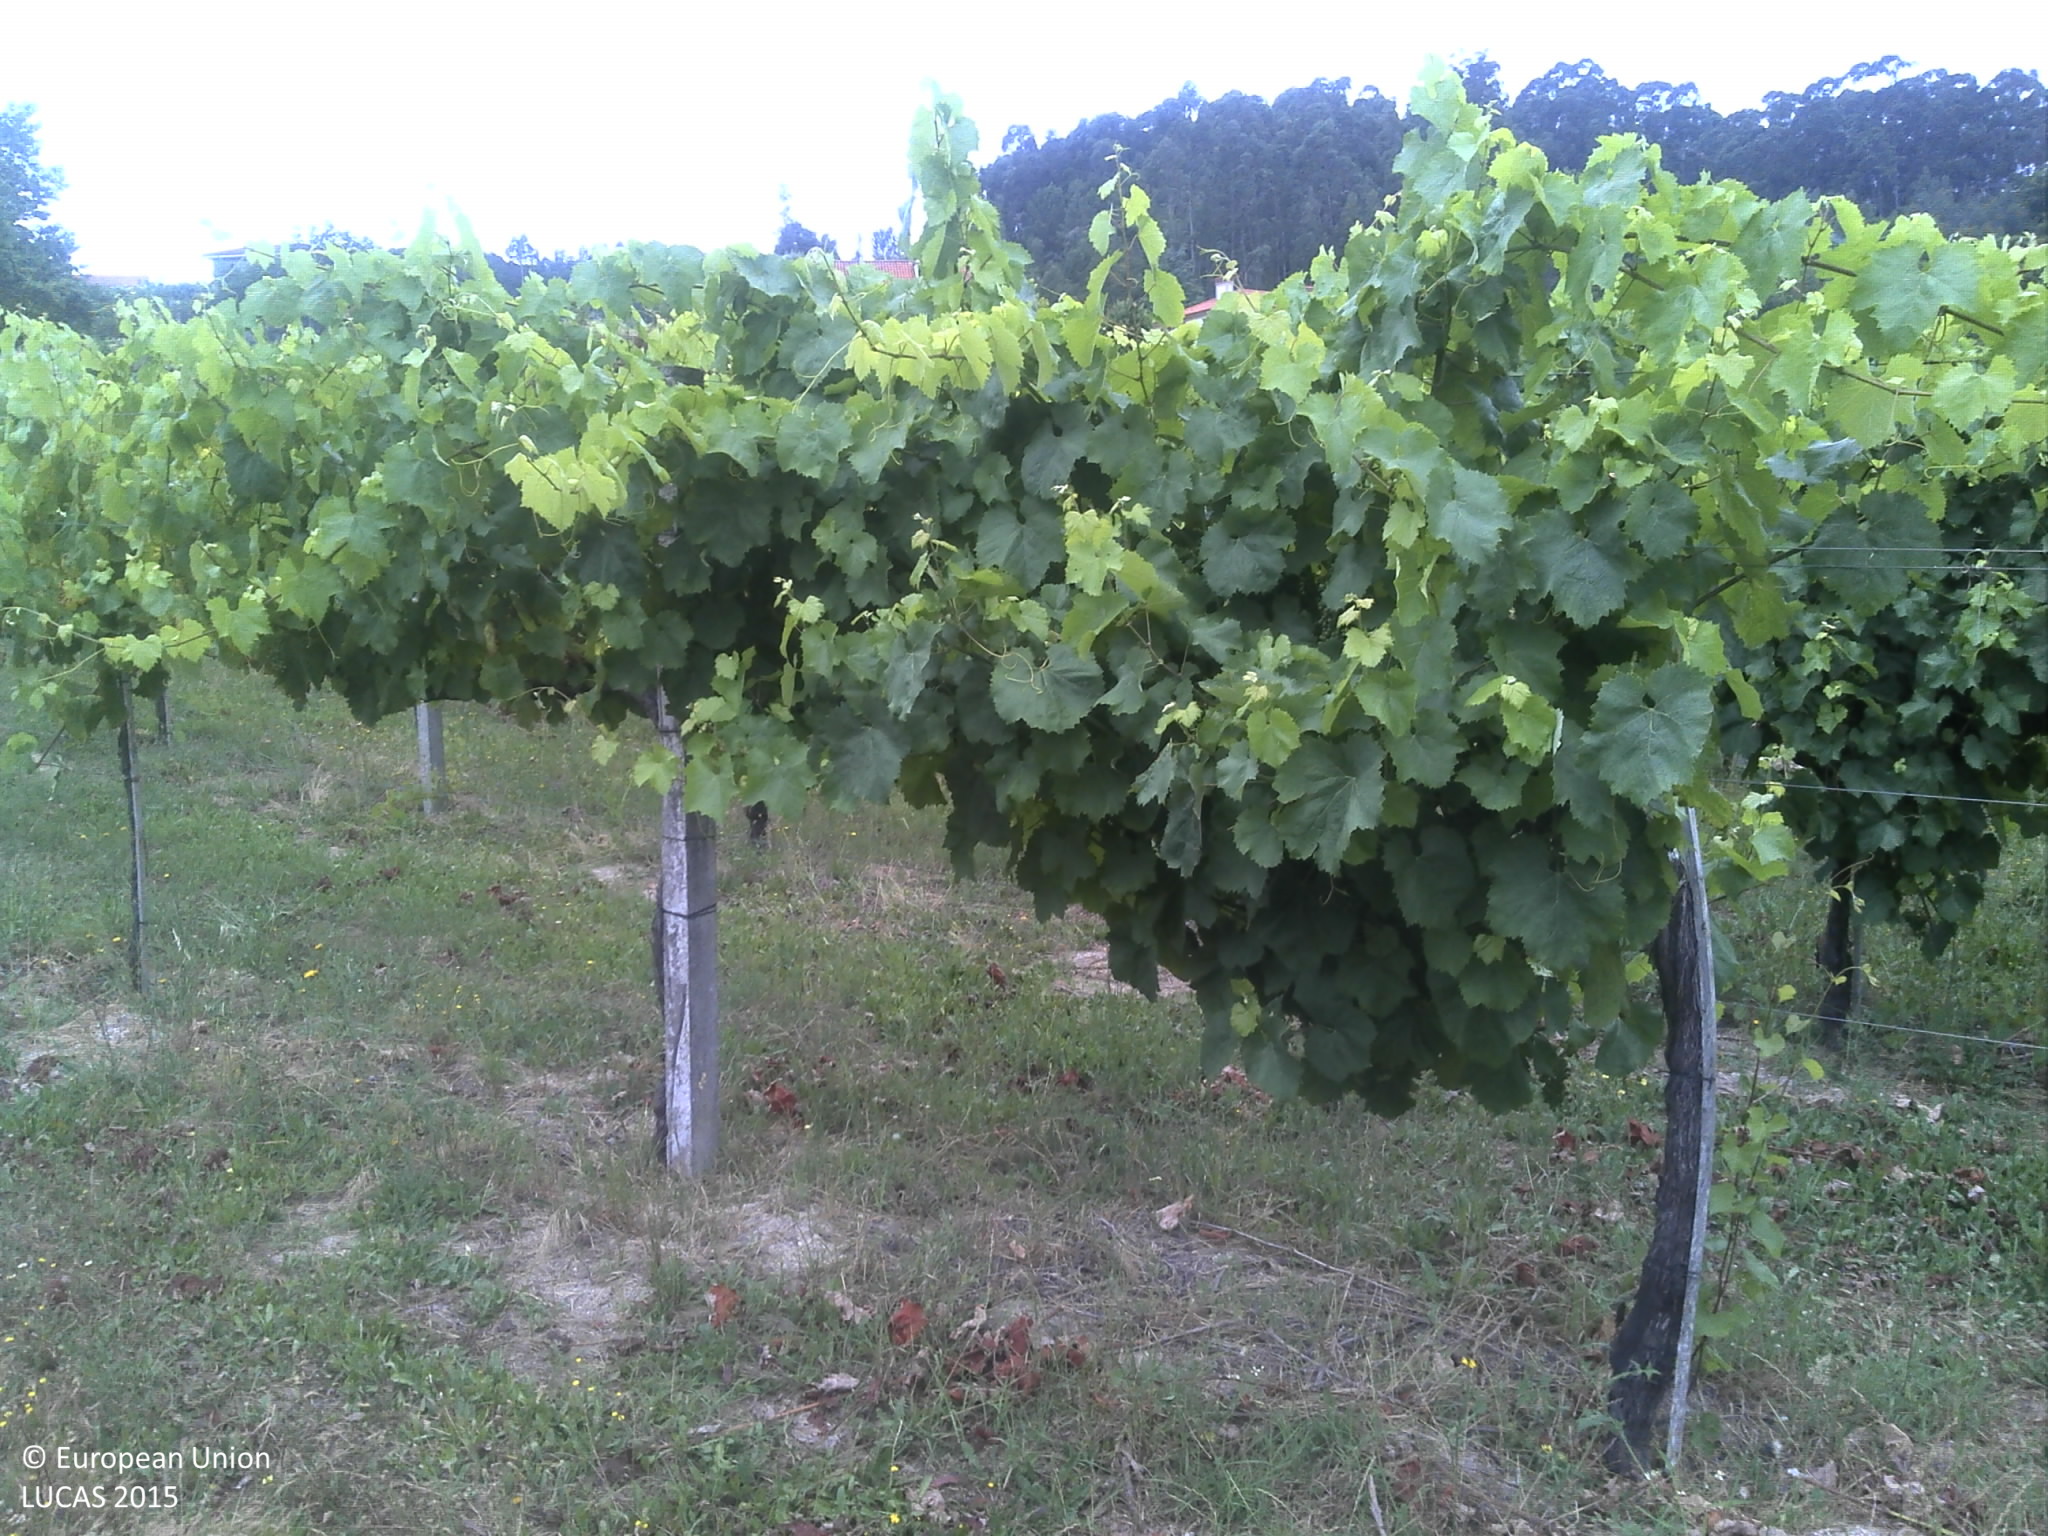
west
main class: Grassland
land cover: Grassland without tree/shrub cover
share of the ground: 50 - 75 %
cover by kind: herbaceous plants 75 %, consolidated bare surface 10 %, unconsolidated bare surface 10 %, shrubs 5 %
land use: Agriculture (excluding fallow land and kitchen gardens)
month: June
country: PT
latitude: 41.1908
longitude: -8.2047
